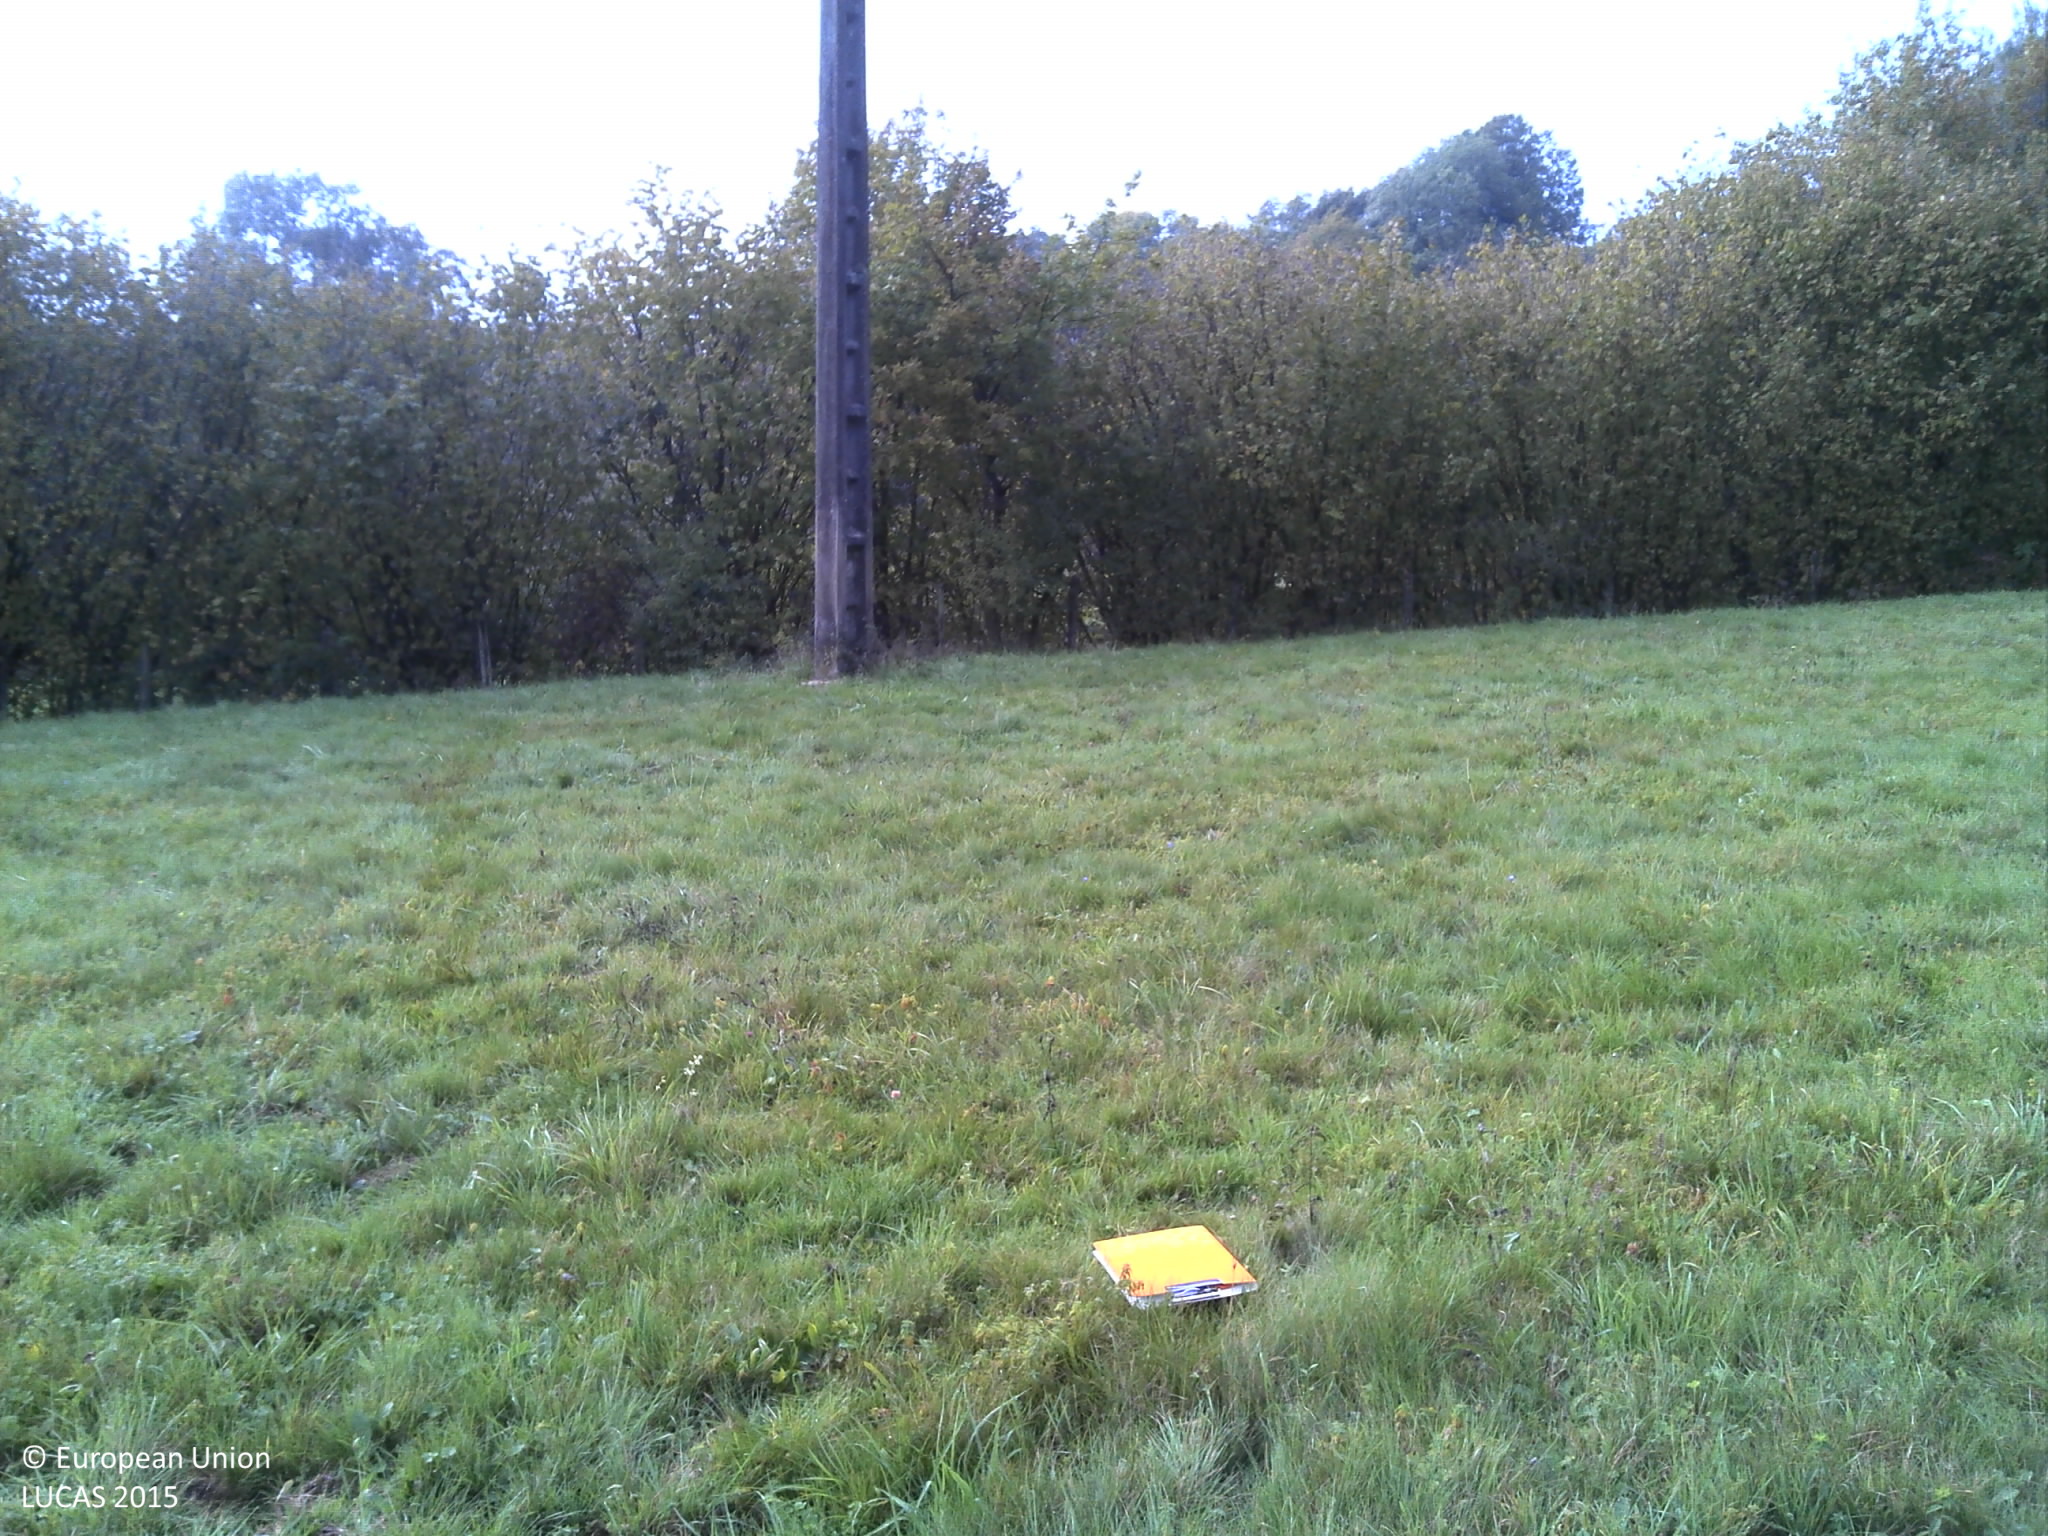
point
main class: Grassland
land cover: Grassland without tree/shrub cover
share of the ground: > 75 %
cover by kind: herbaceous plants 100 %
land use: Agriculture (excluding fallow land and kitchen gardens)
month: October
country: FR
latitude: 46.1073
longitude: 5.3846
